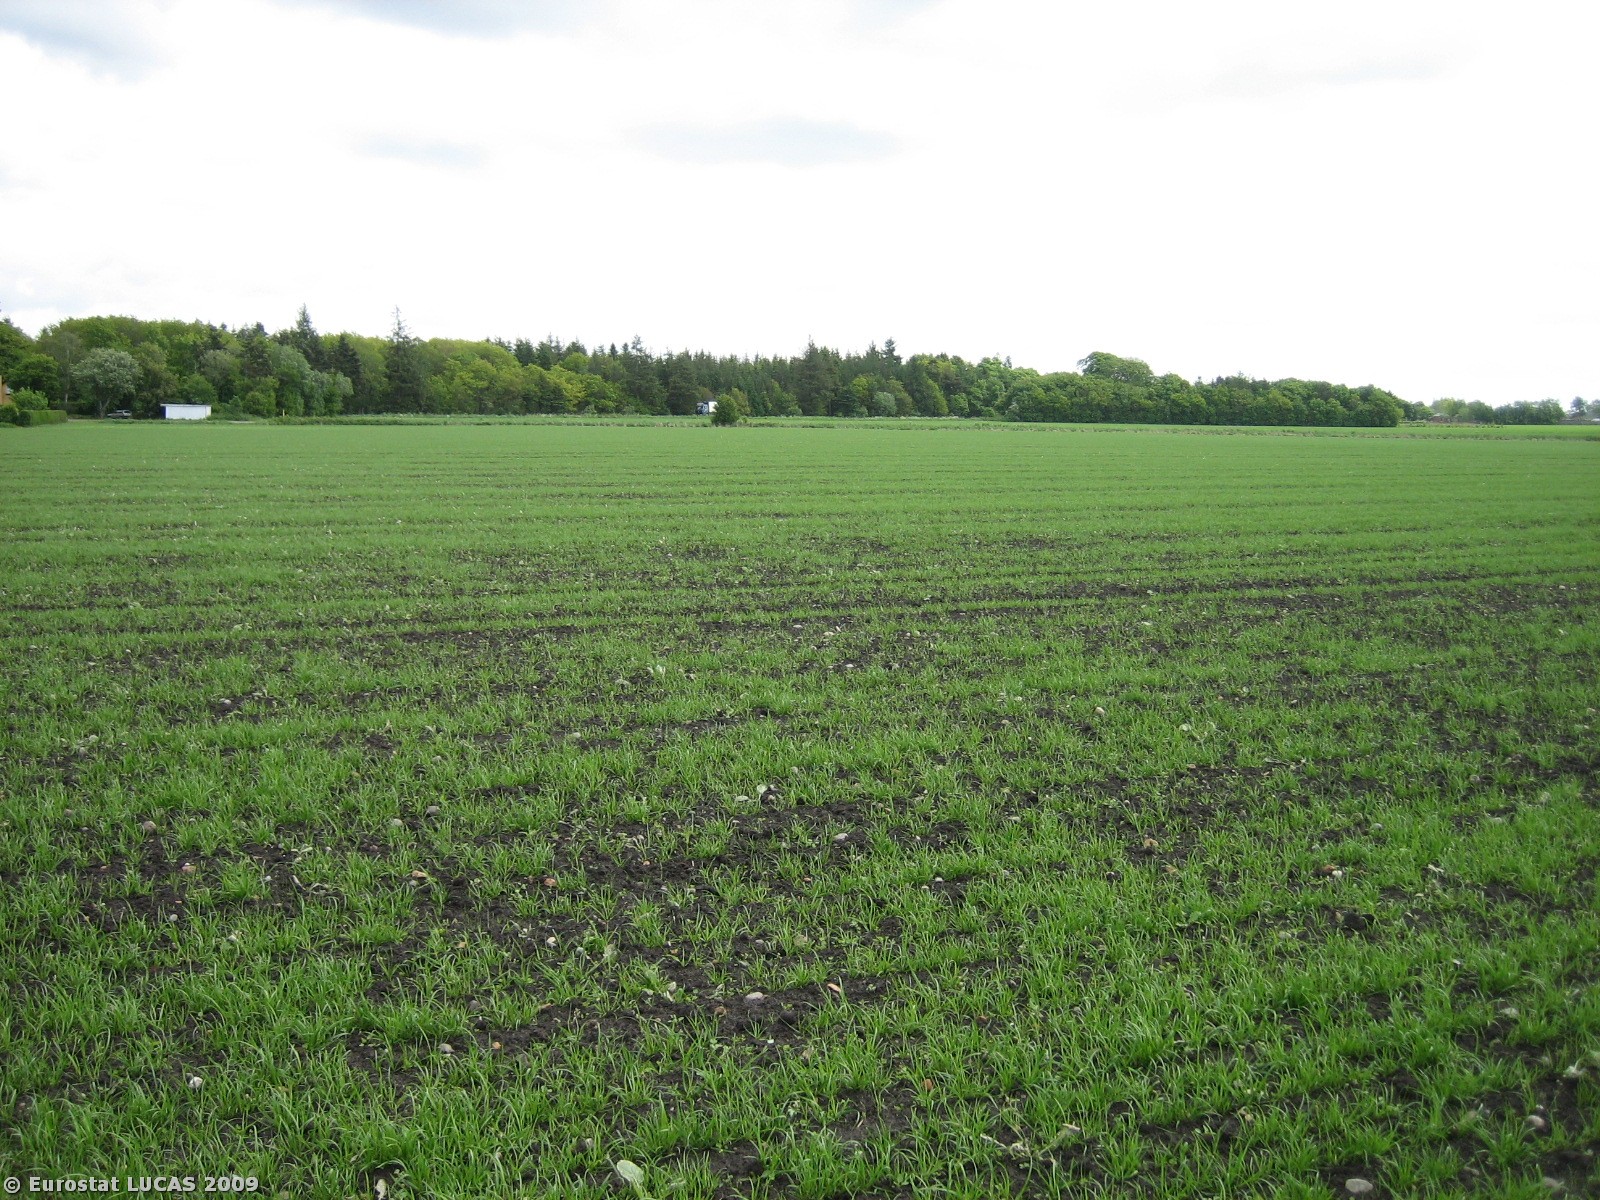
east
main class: Cropland
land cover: Common wheat
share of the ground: > 75 %
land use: Agriculture (excluding fallow land and kitchen gardens)
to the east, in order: Common wheat; Rye; Grass margins; Ditches and canals; Grass margins; Paved roads, cycling and walking lanes; Grass margins; Ditches and canals; Grass margins; Barley
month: May
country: DK
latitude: 56.1824
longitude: 8.8253
